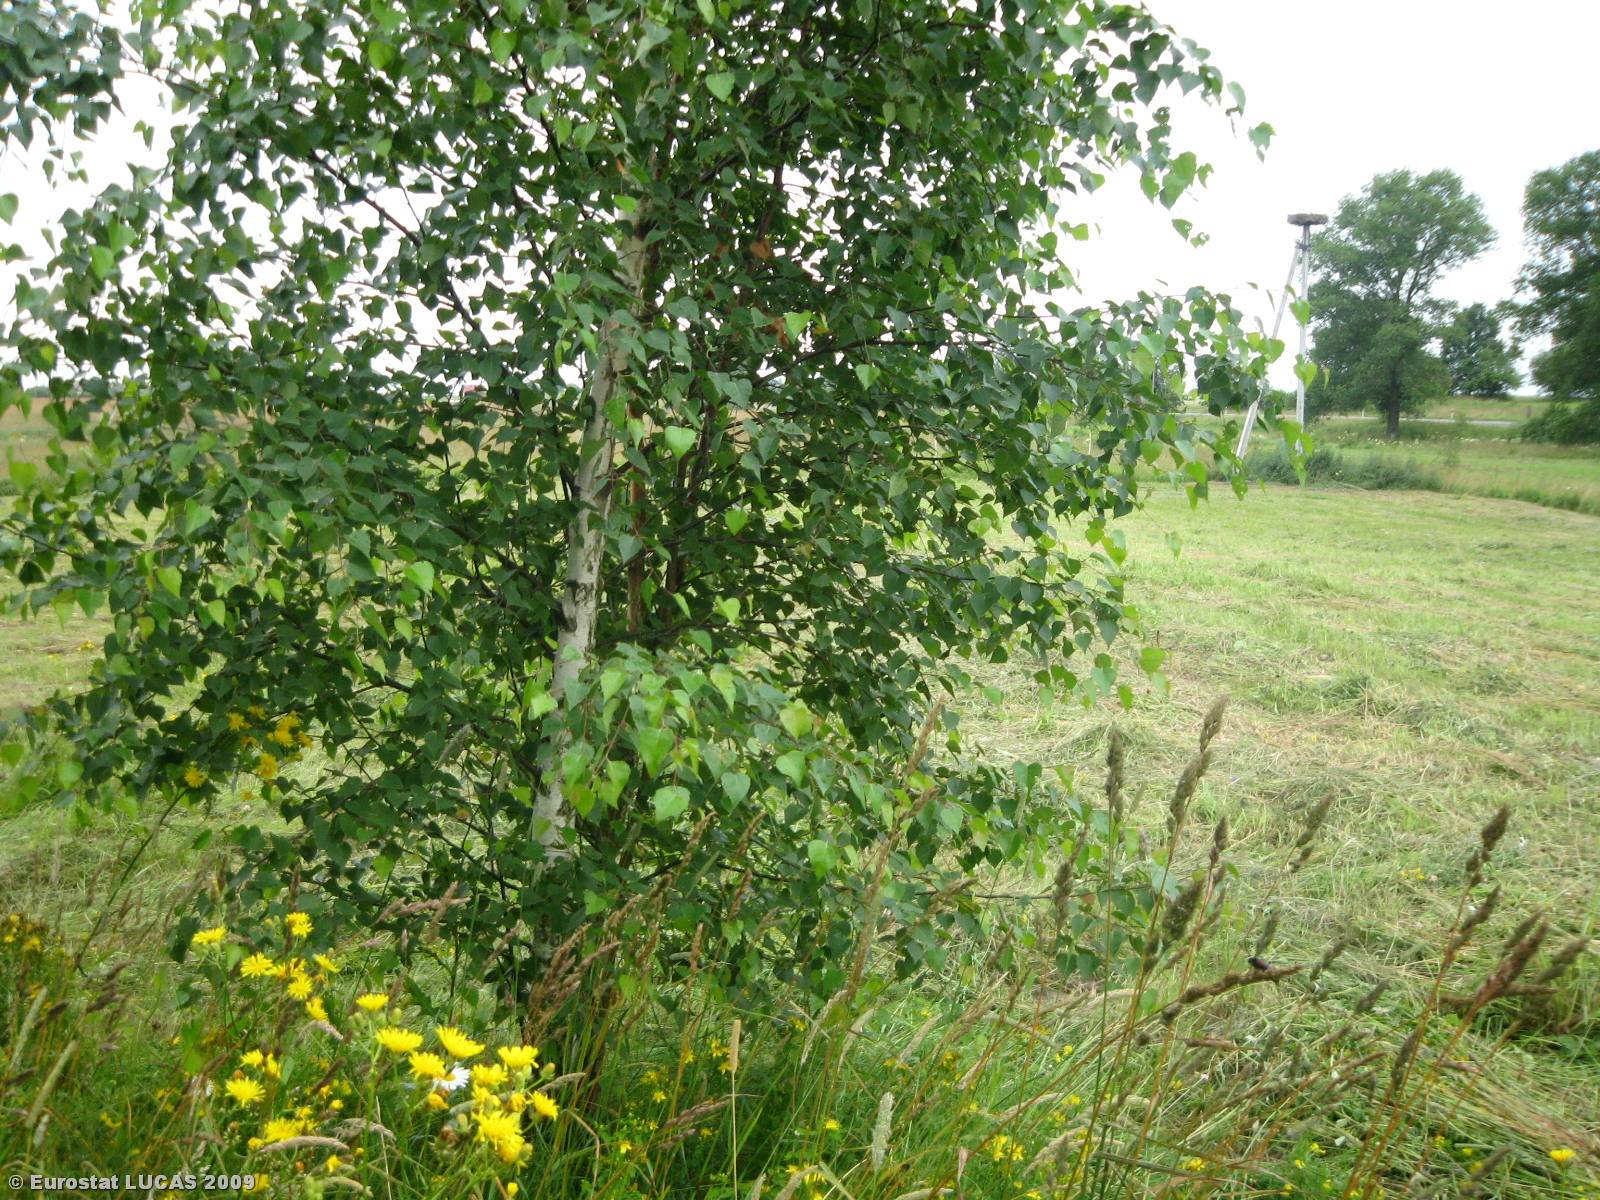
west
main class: Woodland
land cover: Broadleaved woodland
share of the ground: 25 - 50 %
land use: Forestry
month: July
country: LT
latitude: 55.2226
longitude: 24.8710
